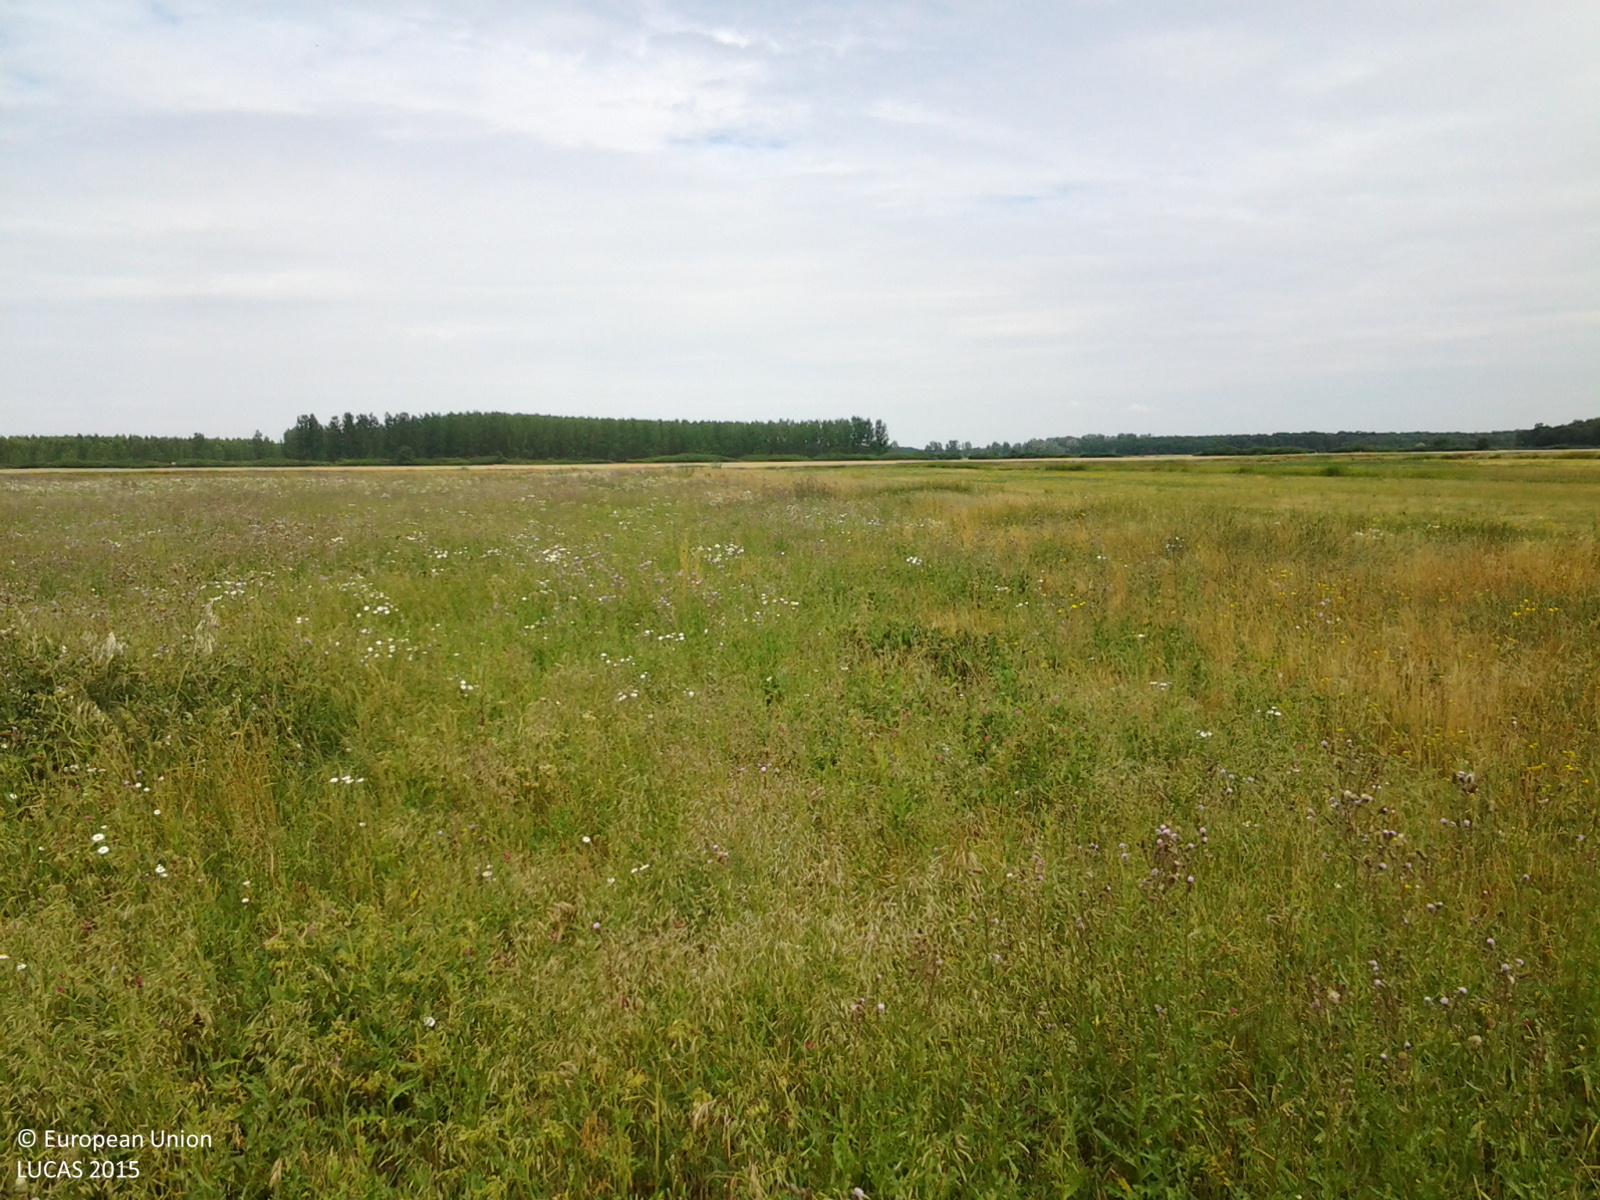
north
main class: Grassland
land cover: Grassland without tree/shrub cover
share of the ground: > 75 %
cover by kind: herbaceous plants 100 %
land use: Agriculture (excluding fallow land and kitchen gardens)
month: June
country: HU
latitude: 46.6317
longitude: 21.3878
